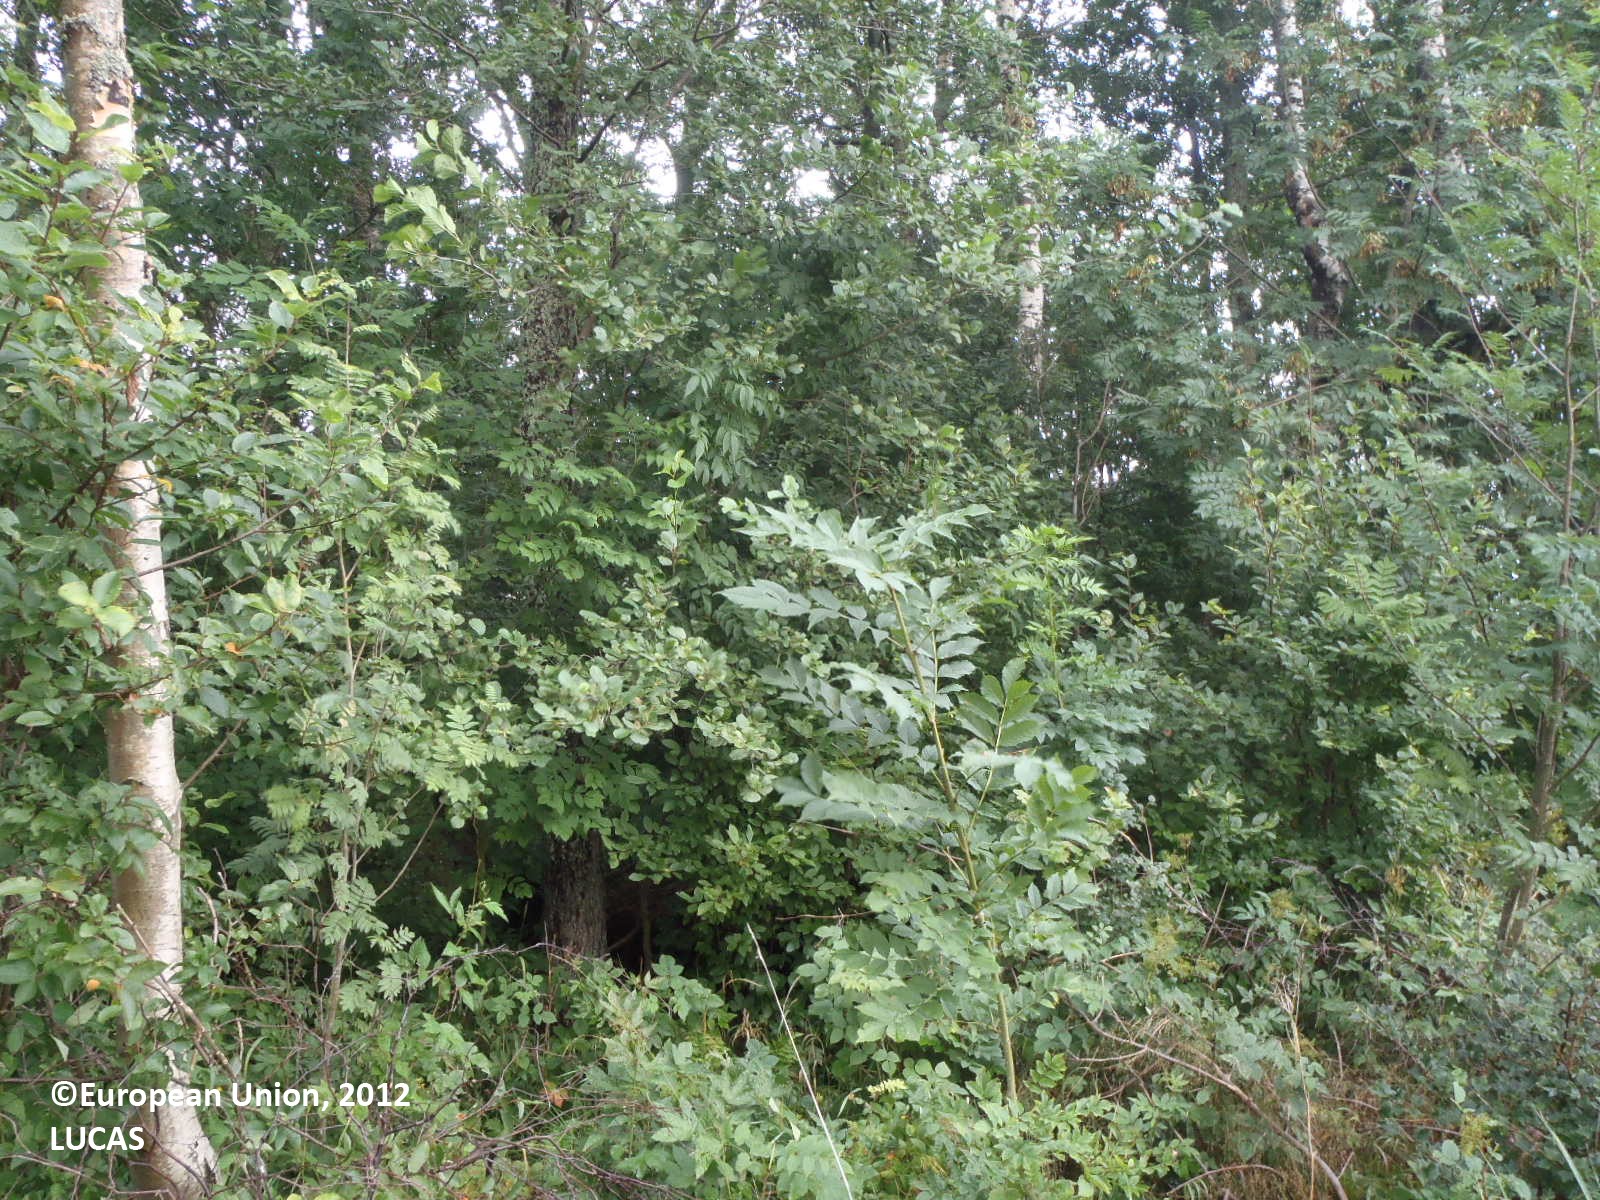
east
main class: Woodland
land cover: Broadleaved woodland
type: hemiboreal forest and nemoral coniferous forest and mixed broadleaved-coniferous forest
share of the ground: > 75 %
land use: Agriculture (excluding fallow land and kitchen gardens)
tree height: > 5 m
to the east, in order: Broadleaved woodland; Grassland with sparse tree/shrub cover; Electric lines; Grassland with sparse tree/shrub cover; Ditches and canals; Grass margins; Fences; Broadleaved woodland; Artificial constructions in urban areas
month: August
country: FI
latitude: 60.1208
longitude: 19.9223
